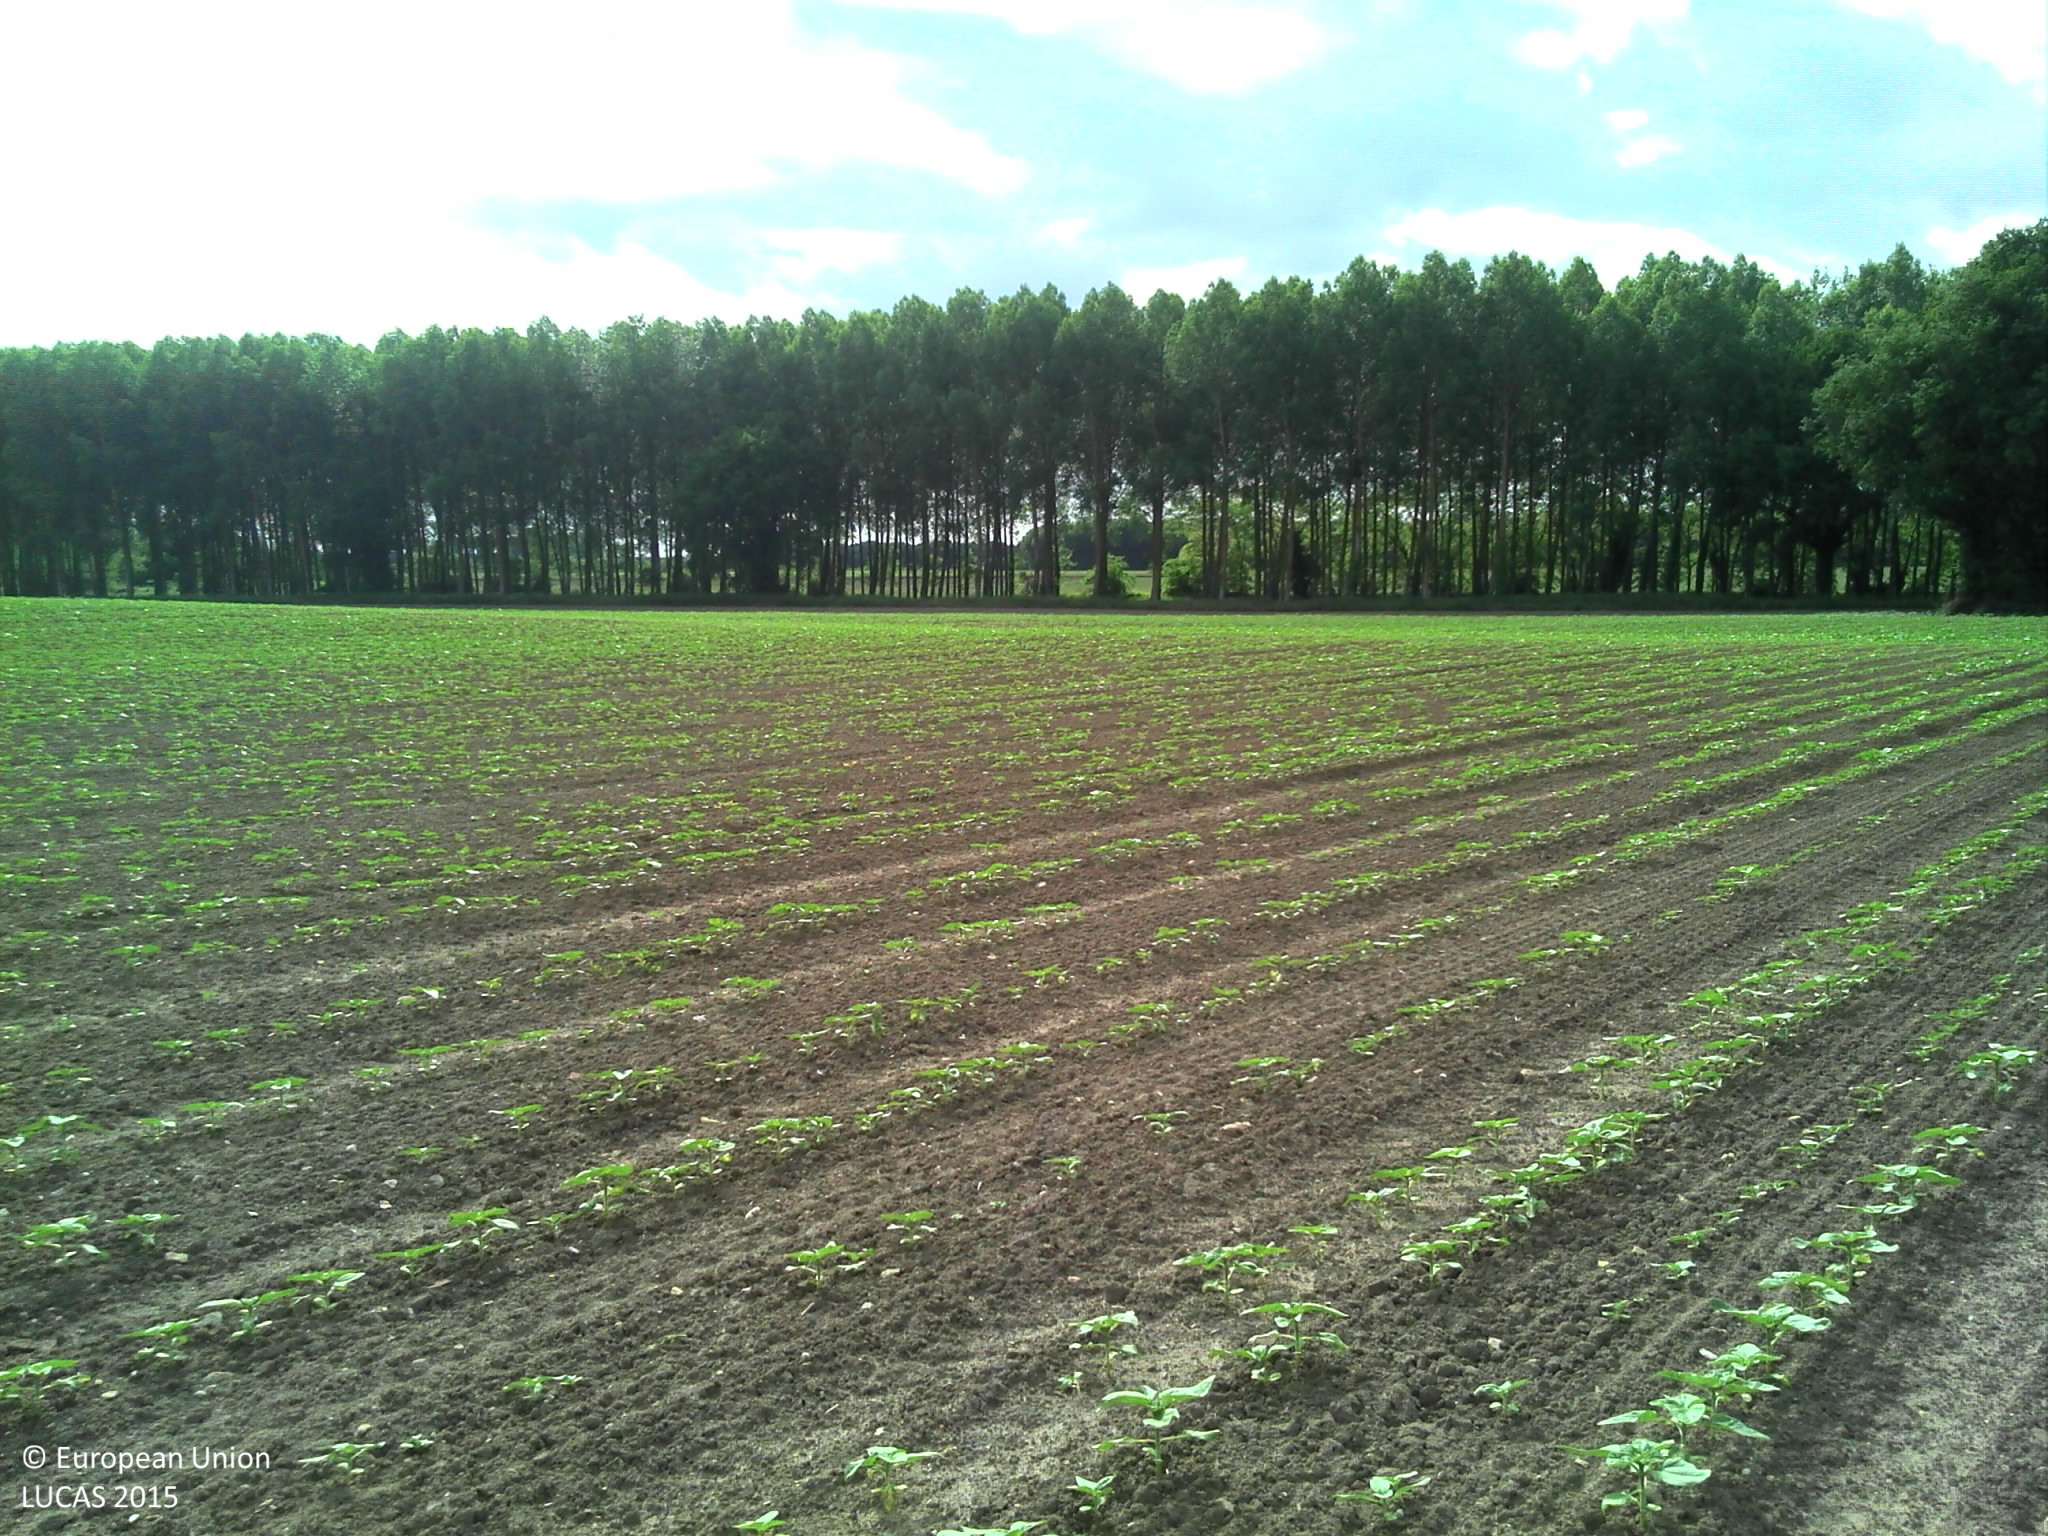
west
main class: Cropland
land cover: Sunflower
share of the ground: 10 - 25 %
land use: Agriculture (excluding fallow land and kitchen gardens)
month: May
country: FR
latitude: 46.8286
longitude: 0.2387
